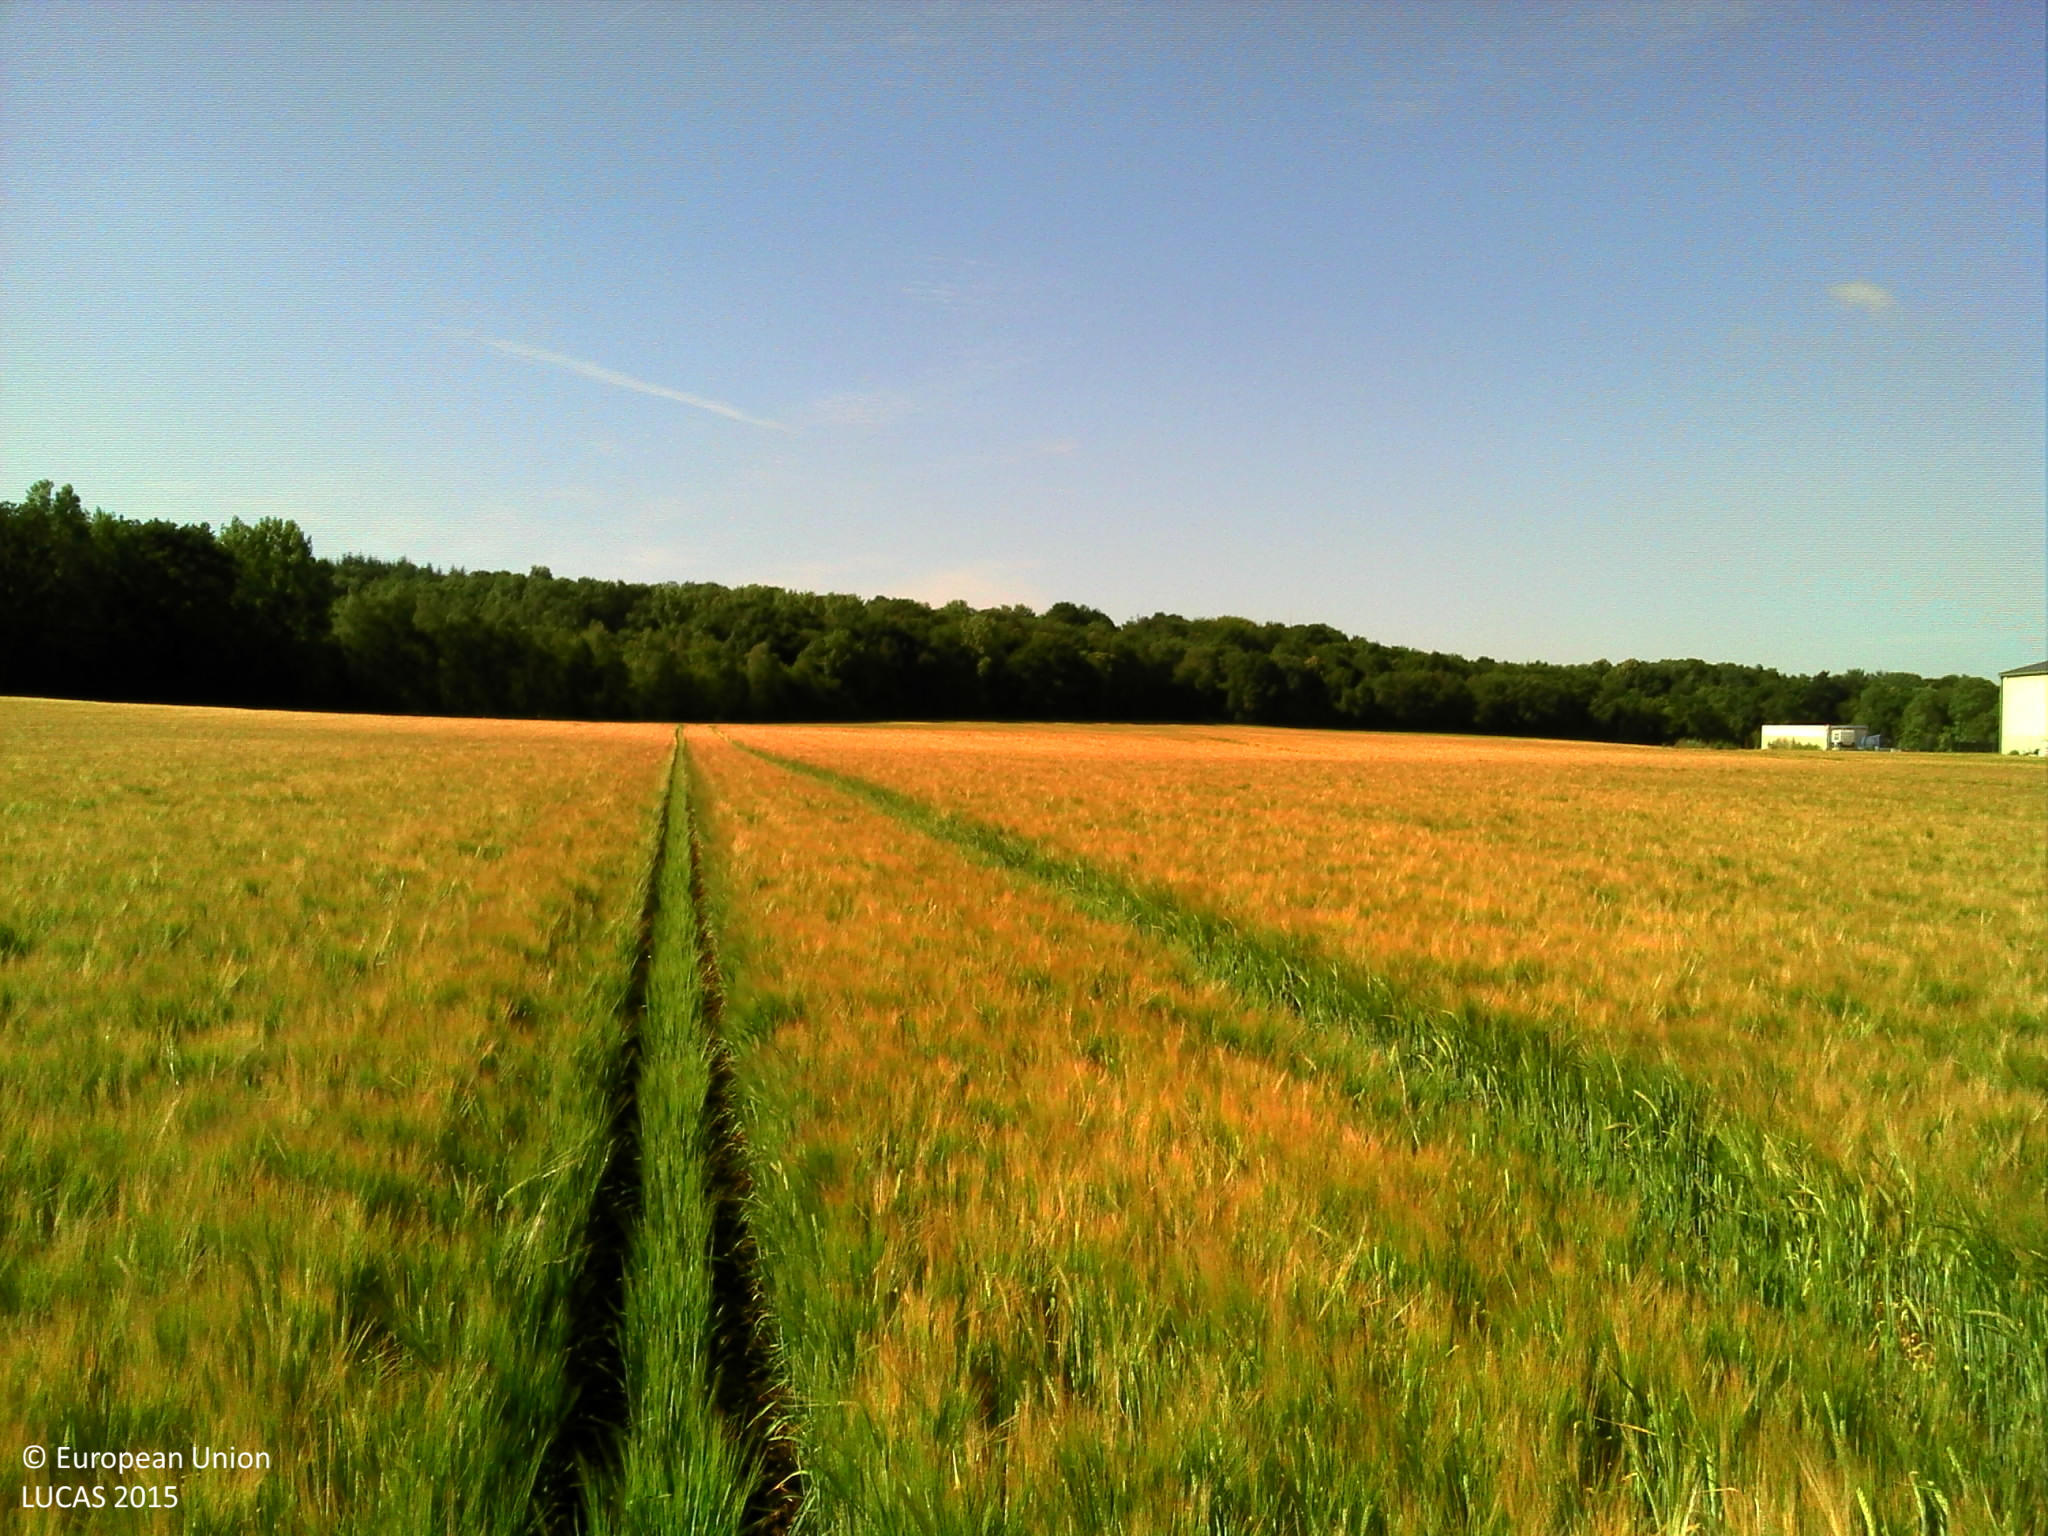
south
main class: Cropland
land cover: Barley
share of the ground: > 75 %
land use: Agriculture (excluding fallow land and kitchen gardens)
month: June
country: FR
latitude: 49.2238
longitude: 2.9192
